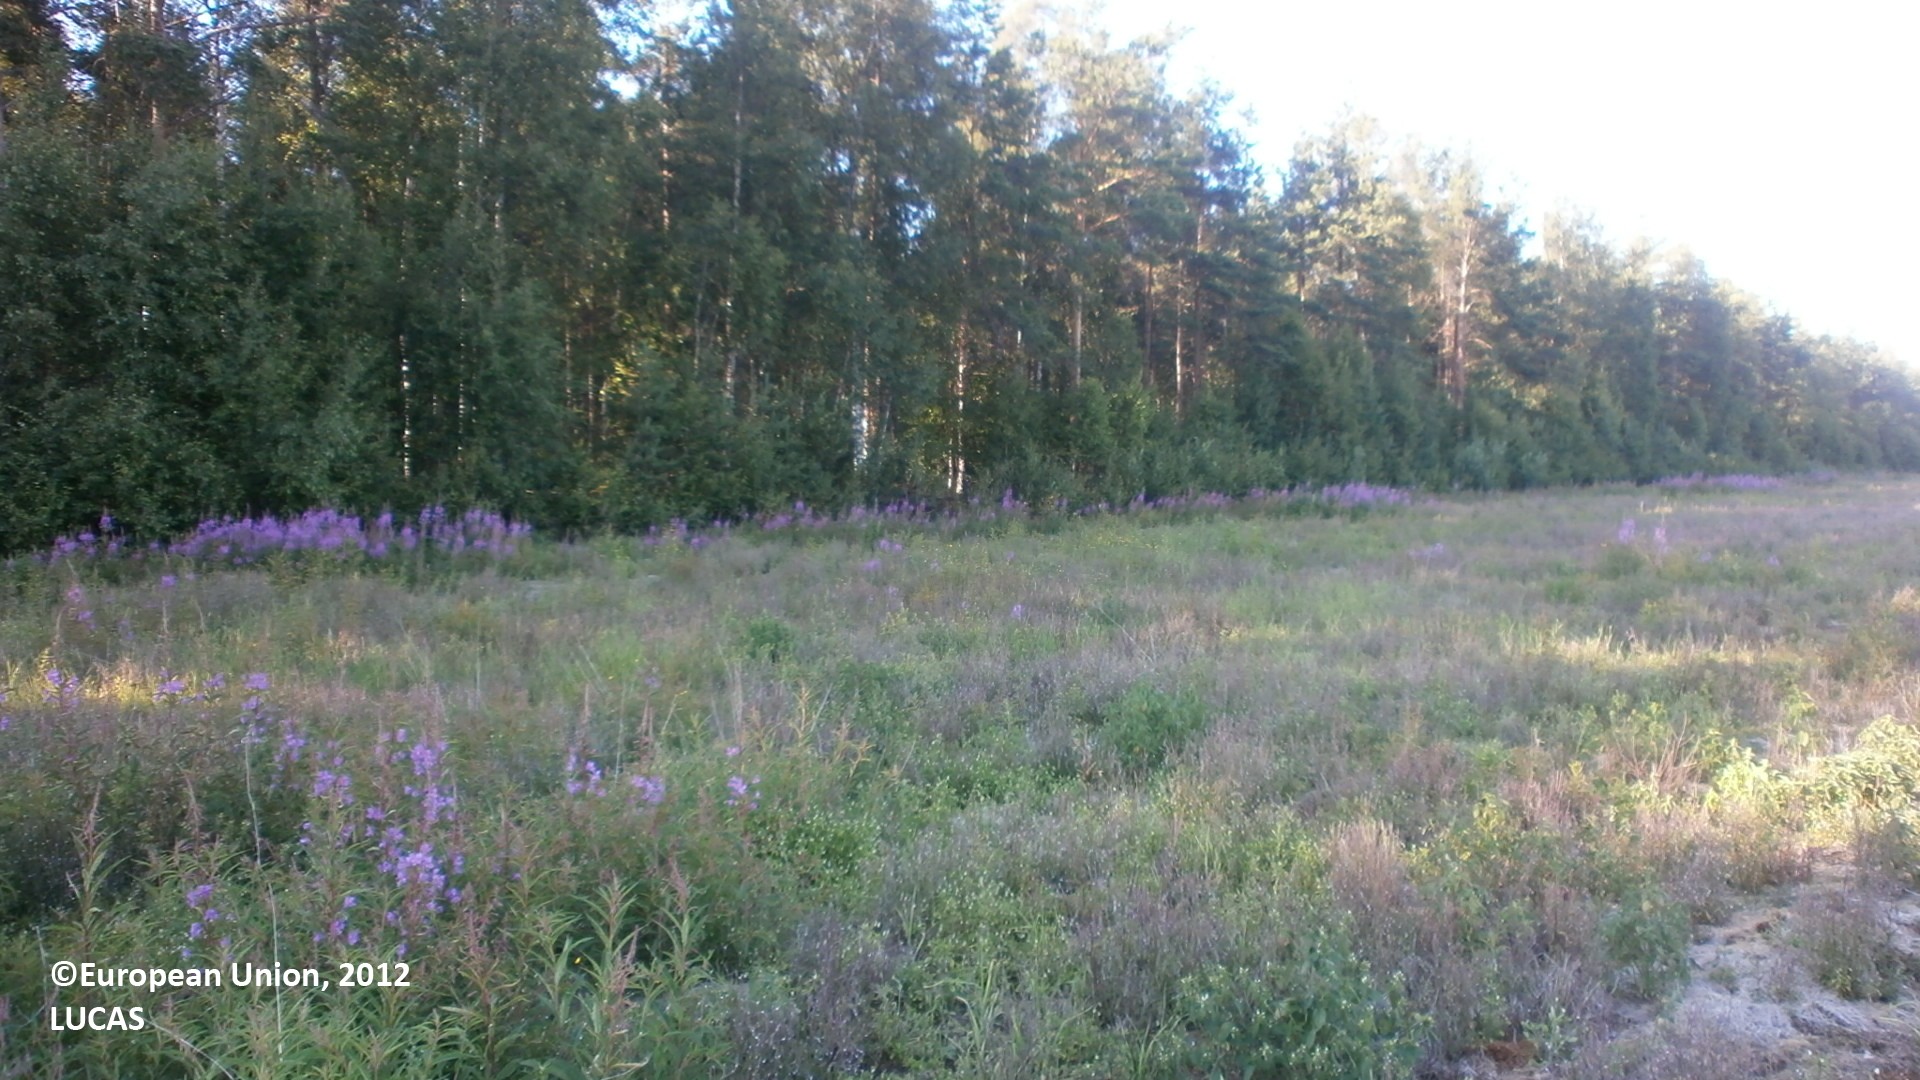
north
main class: Grassland
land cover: Grassland without tree/shrub cover
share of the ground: > 75 %
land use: Fallow land
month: July
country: FI
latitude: 64.0272
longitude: 24.0440
